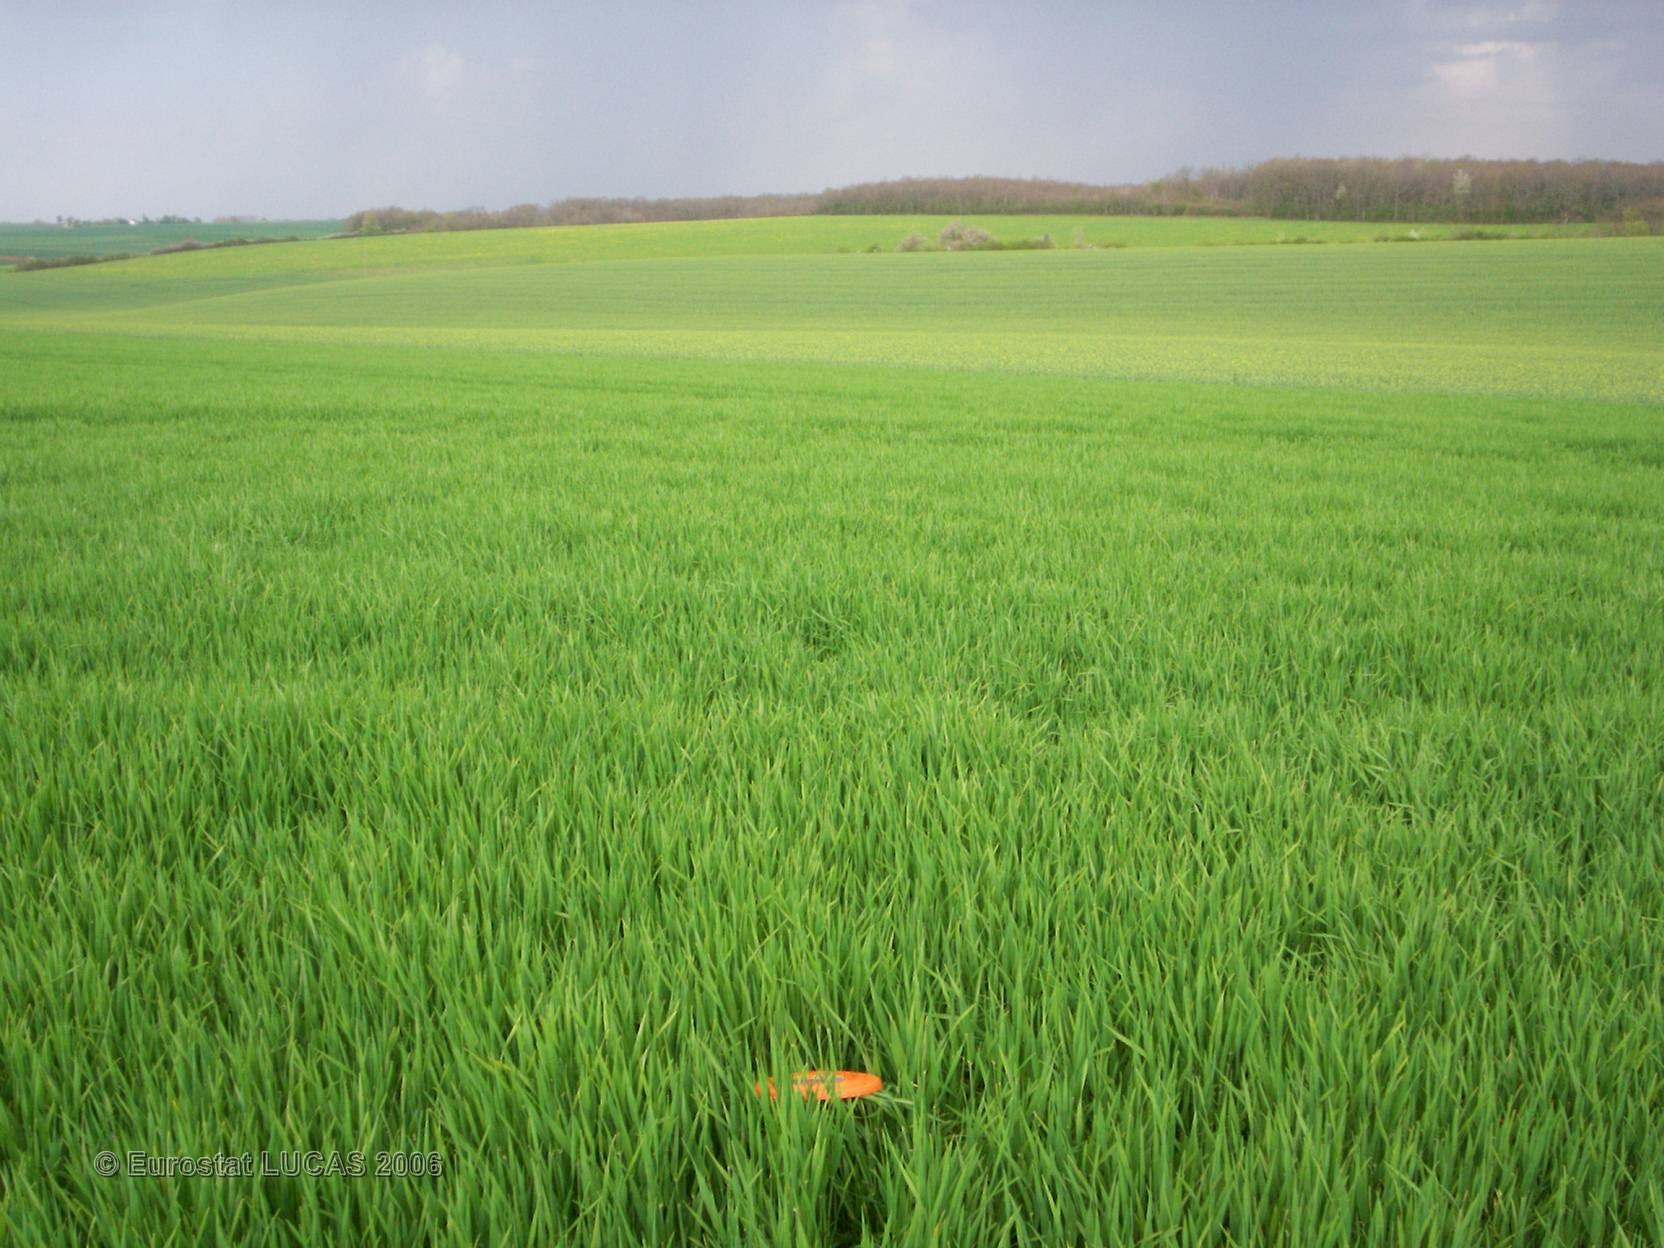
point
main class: Cropland
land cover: Barley
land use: Agriculture (excluding fallow land and kitchen gardens)
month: April
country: FR
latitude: 47.3910
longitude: 3.0662
